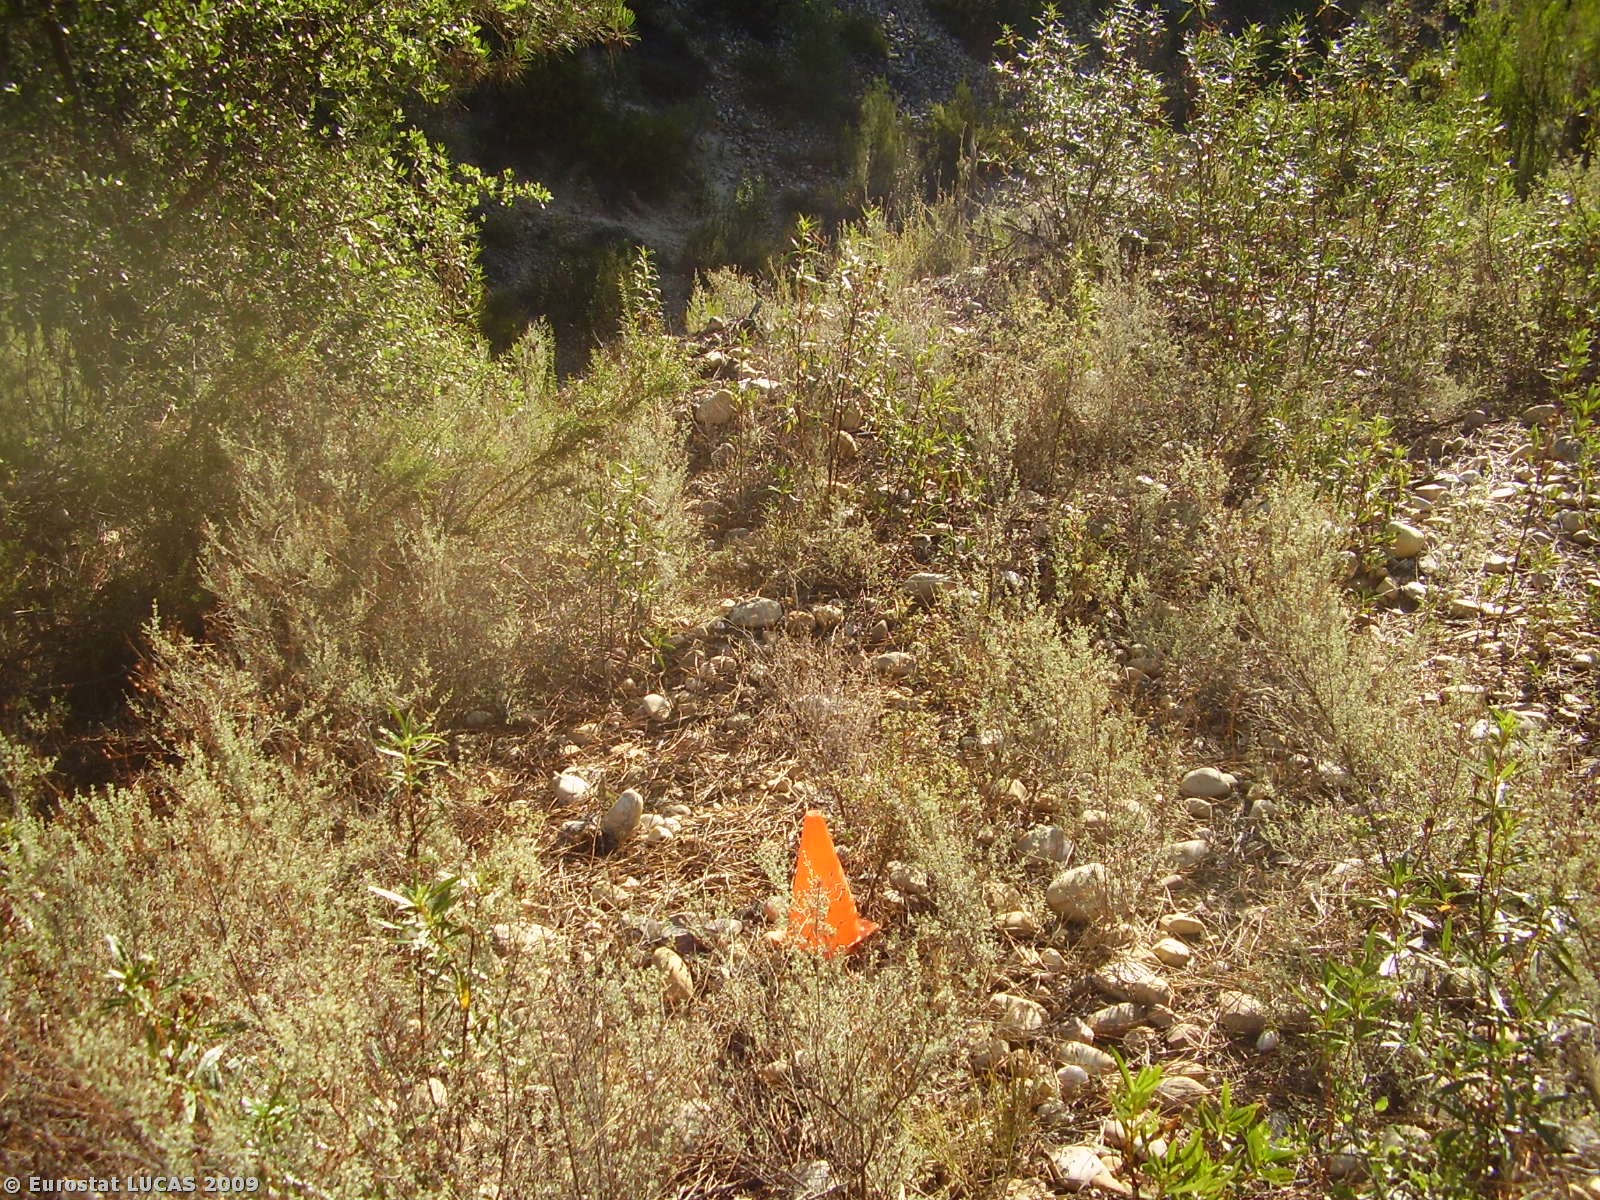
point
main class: Woodland
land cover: Mixed woodland
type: broadleaved evergreen forest
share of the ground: < 10 %
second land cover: Shrubland with sparse tree cover
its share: 25 - 50 %
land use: Forestry
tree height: > 5 m
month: July
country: PT
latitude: 39.3791
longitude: -8.1117
